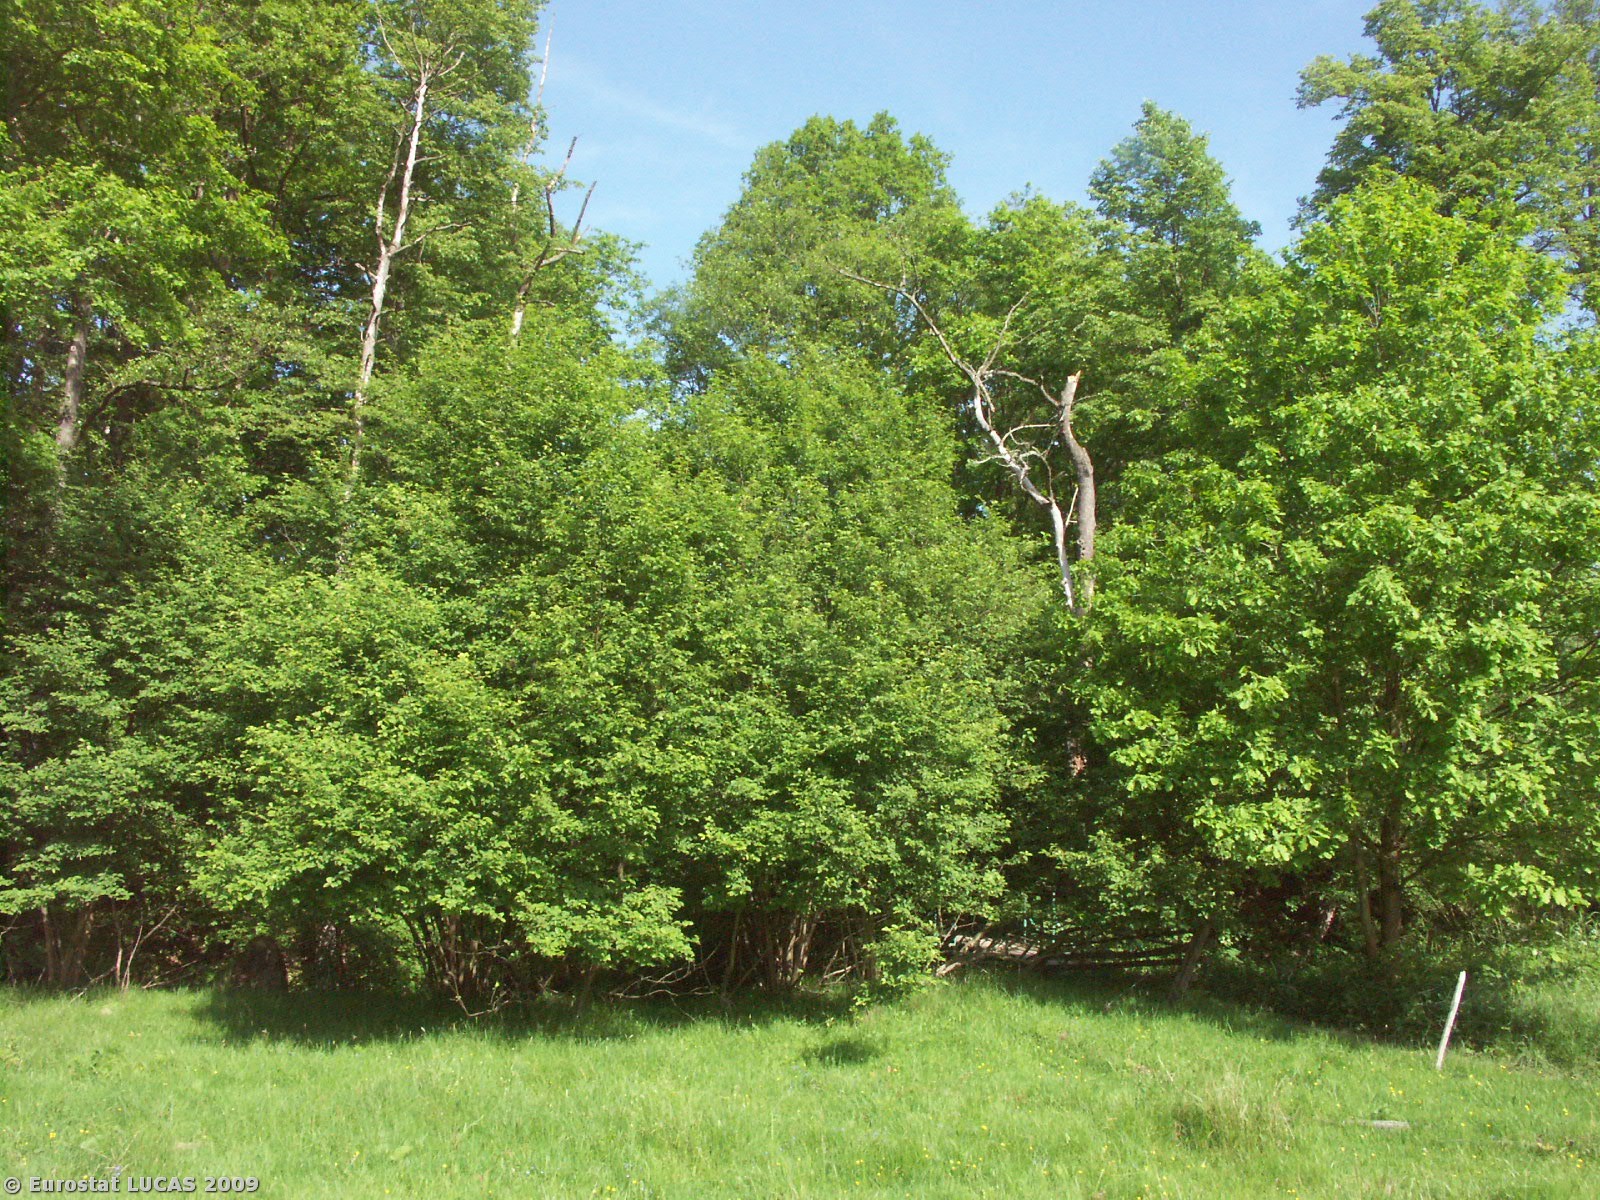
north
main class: Grassland
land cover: Grassland without tree/shrub cover
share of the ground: > 75 %
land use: Agriculture (excluding fallow land and kitchen gardens)
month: May
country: CZ
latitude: 48.8835
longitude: 14.6242
